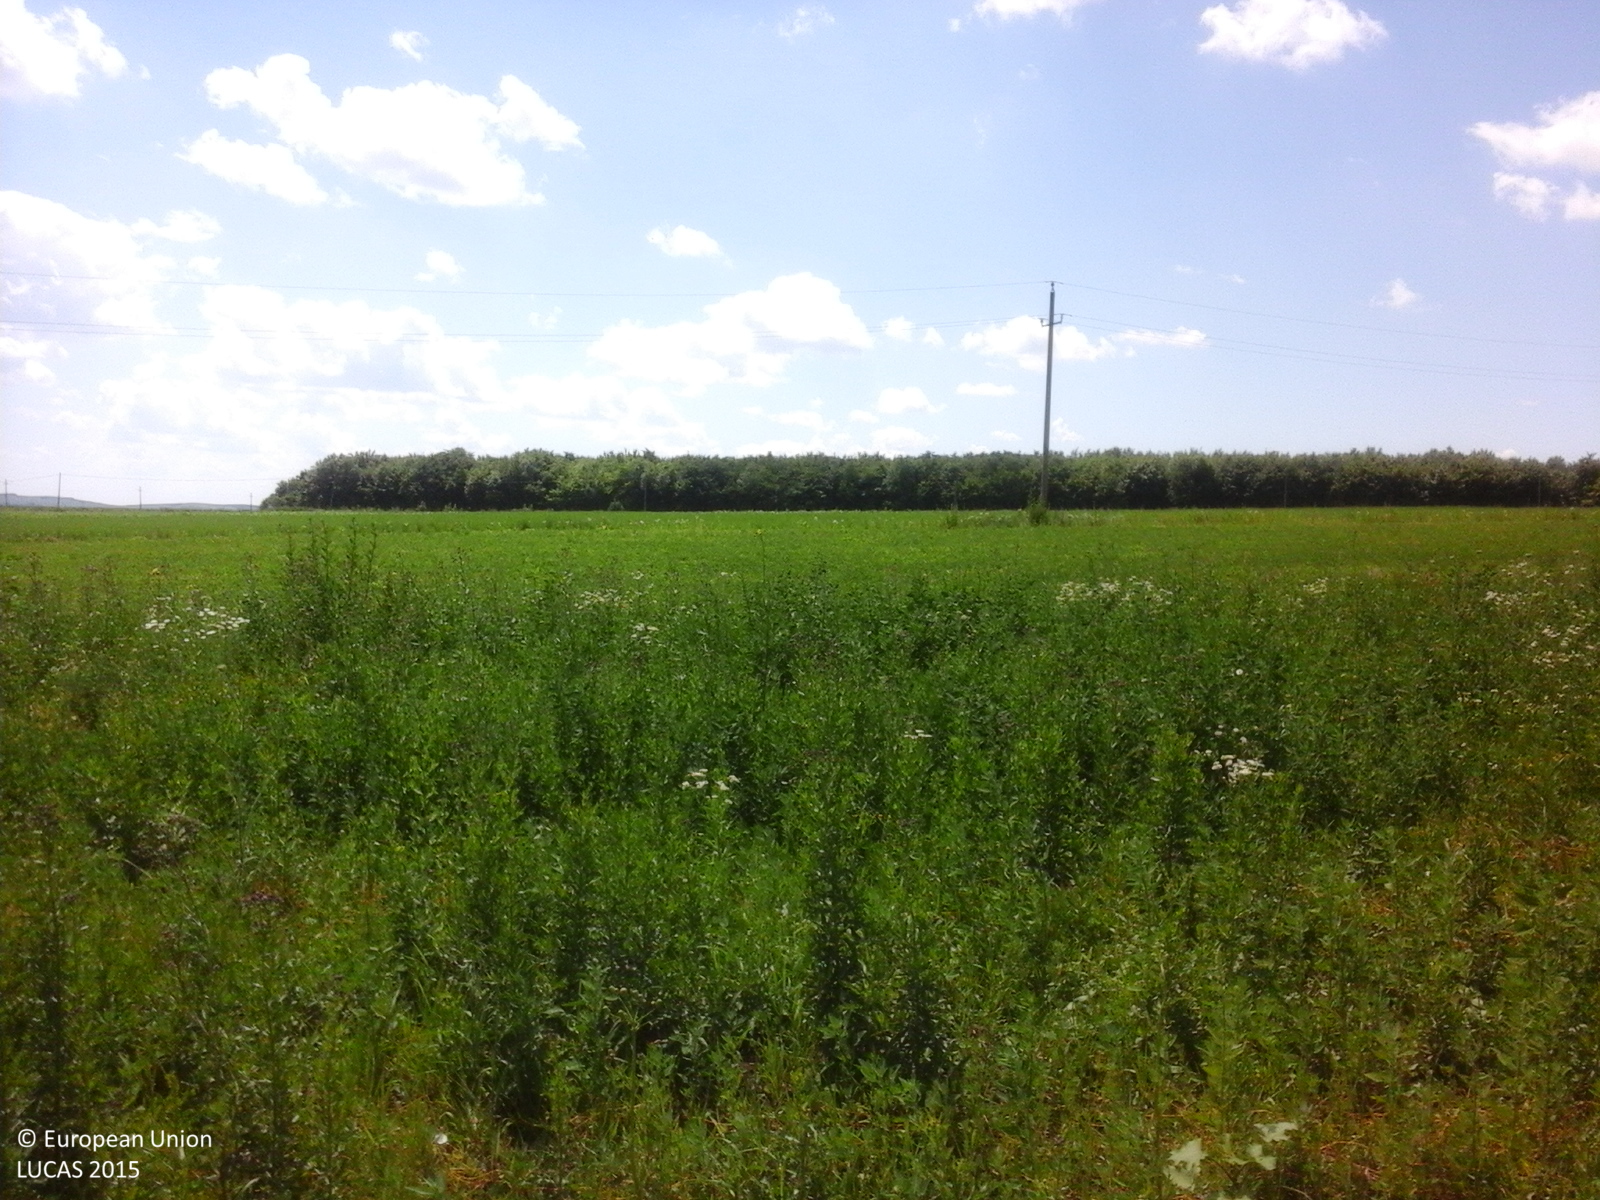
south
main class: Grassland
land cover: Spontaneously vegetated surfaces
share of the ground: 25 - 50 %
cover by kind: unconsolidated bare surface 60 %, herbaceous plants 40 %
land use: Fallow land
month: June
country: RO
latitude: 47.0581
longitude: 27.0995
